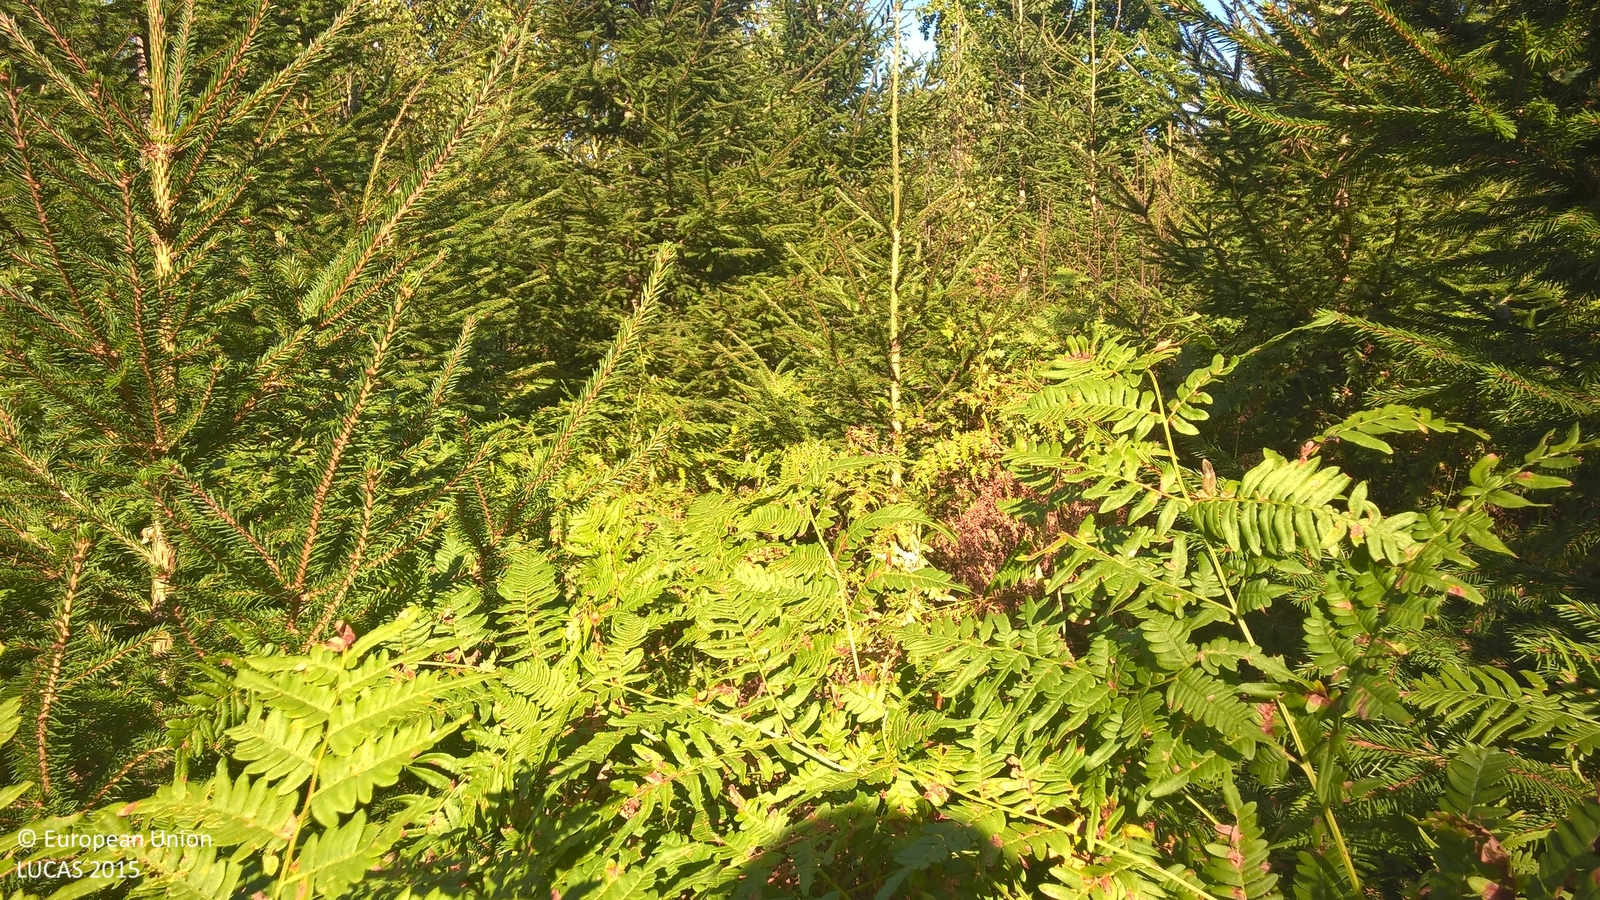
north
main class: Woodland
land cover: Spruce dominated mixed woodland
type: hemiboreal forest and nemoral coniferous forest and mixed broadleaved-coniferous forest
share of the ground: > 75 %
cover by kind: broadleaved forest trees 50 %, coniferous forest trees 30 %, shrubs 10 %, herbaceous plants 10 %
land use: Forestry
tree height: > 5 m
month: September
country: LV
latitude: 57.3948
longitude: 25.5755
